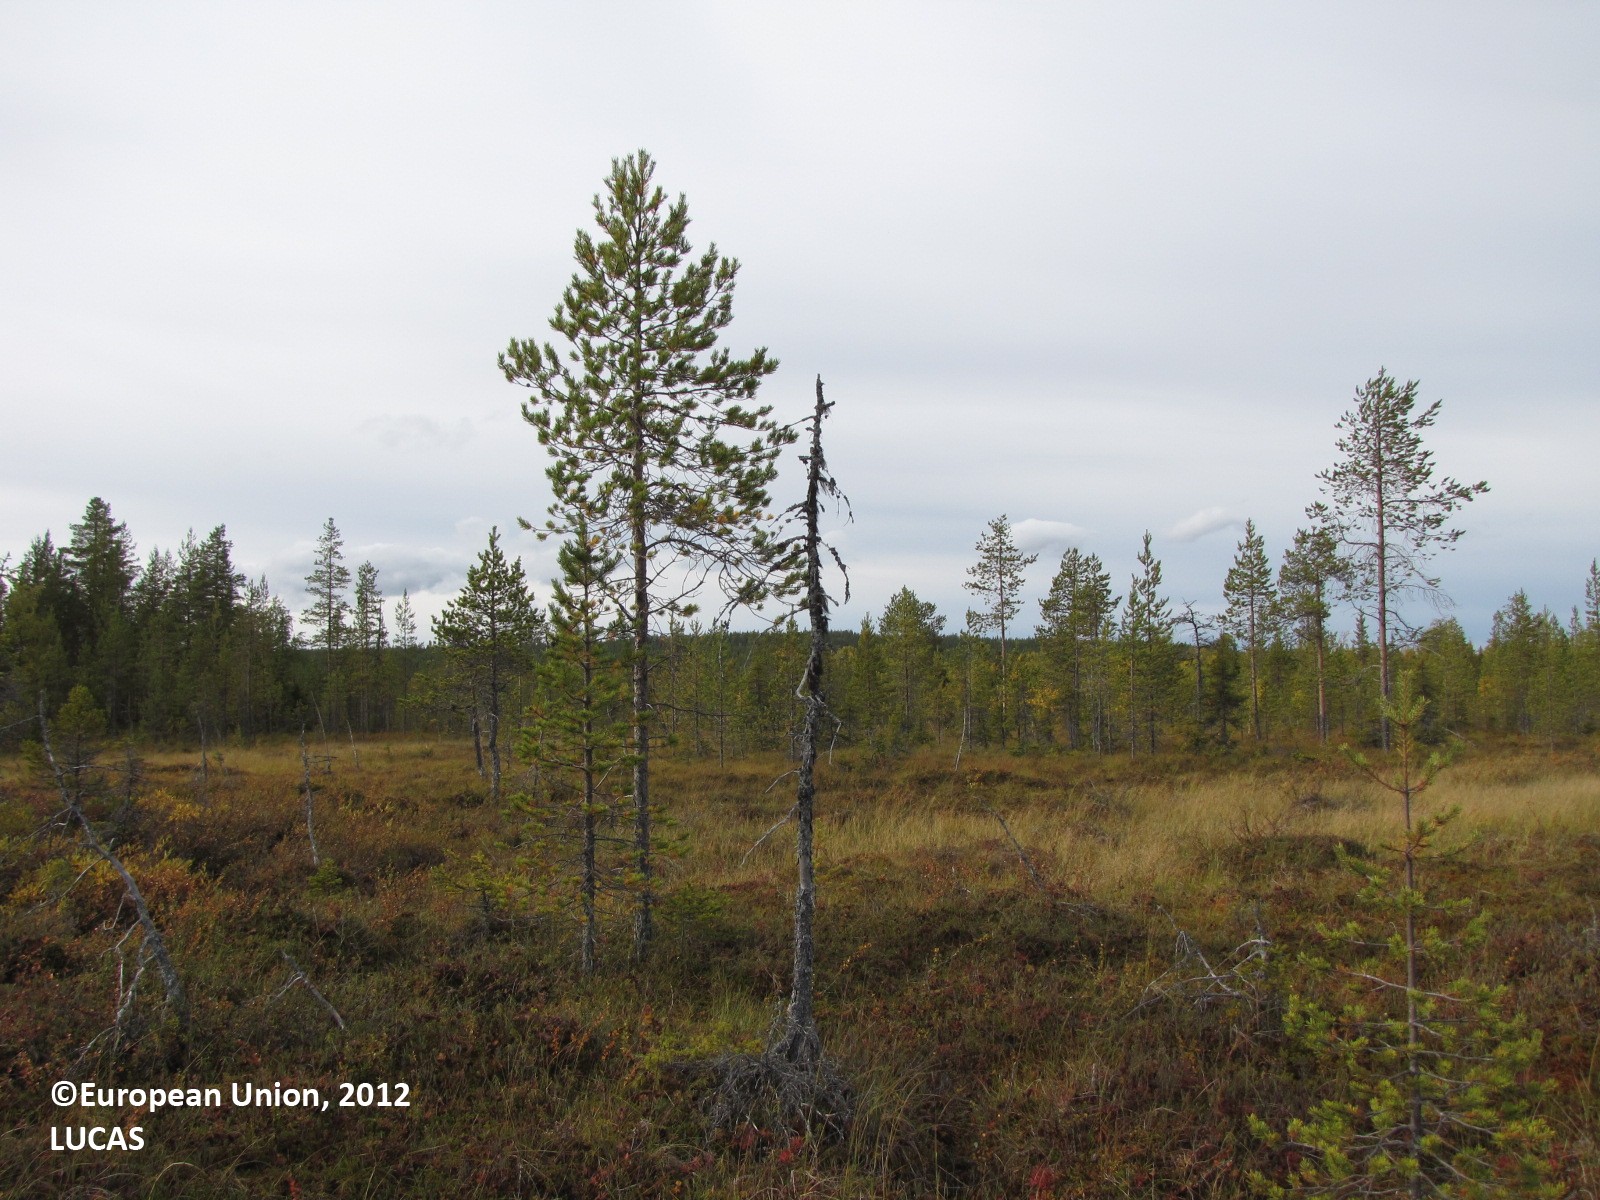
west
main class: Woodland
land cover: Pine dominated coniferous woodland
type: boreal forest
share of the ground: 10 - 25 %
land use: Forestry
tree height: < 5 m
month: September
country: FI
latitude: 67.1478
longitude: 24.8794
